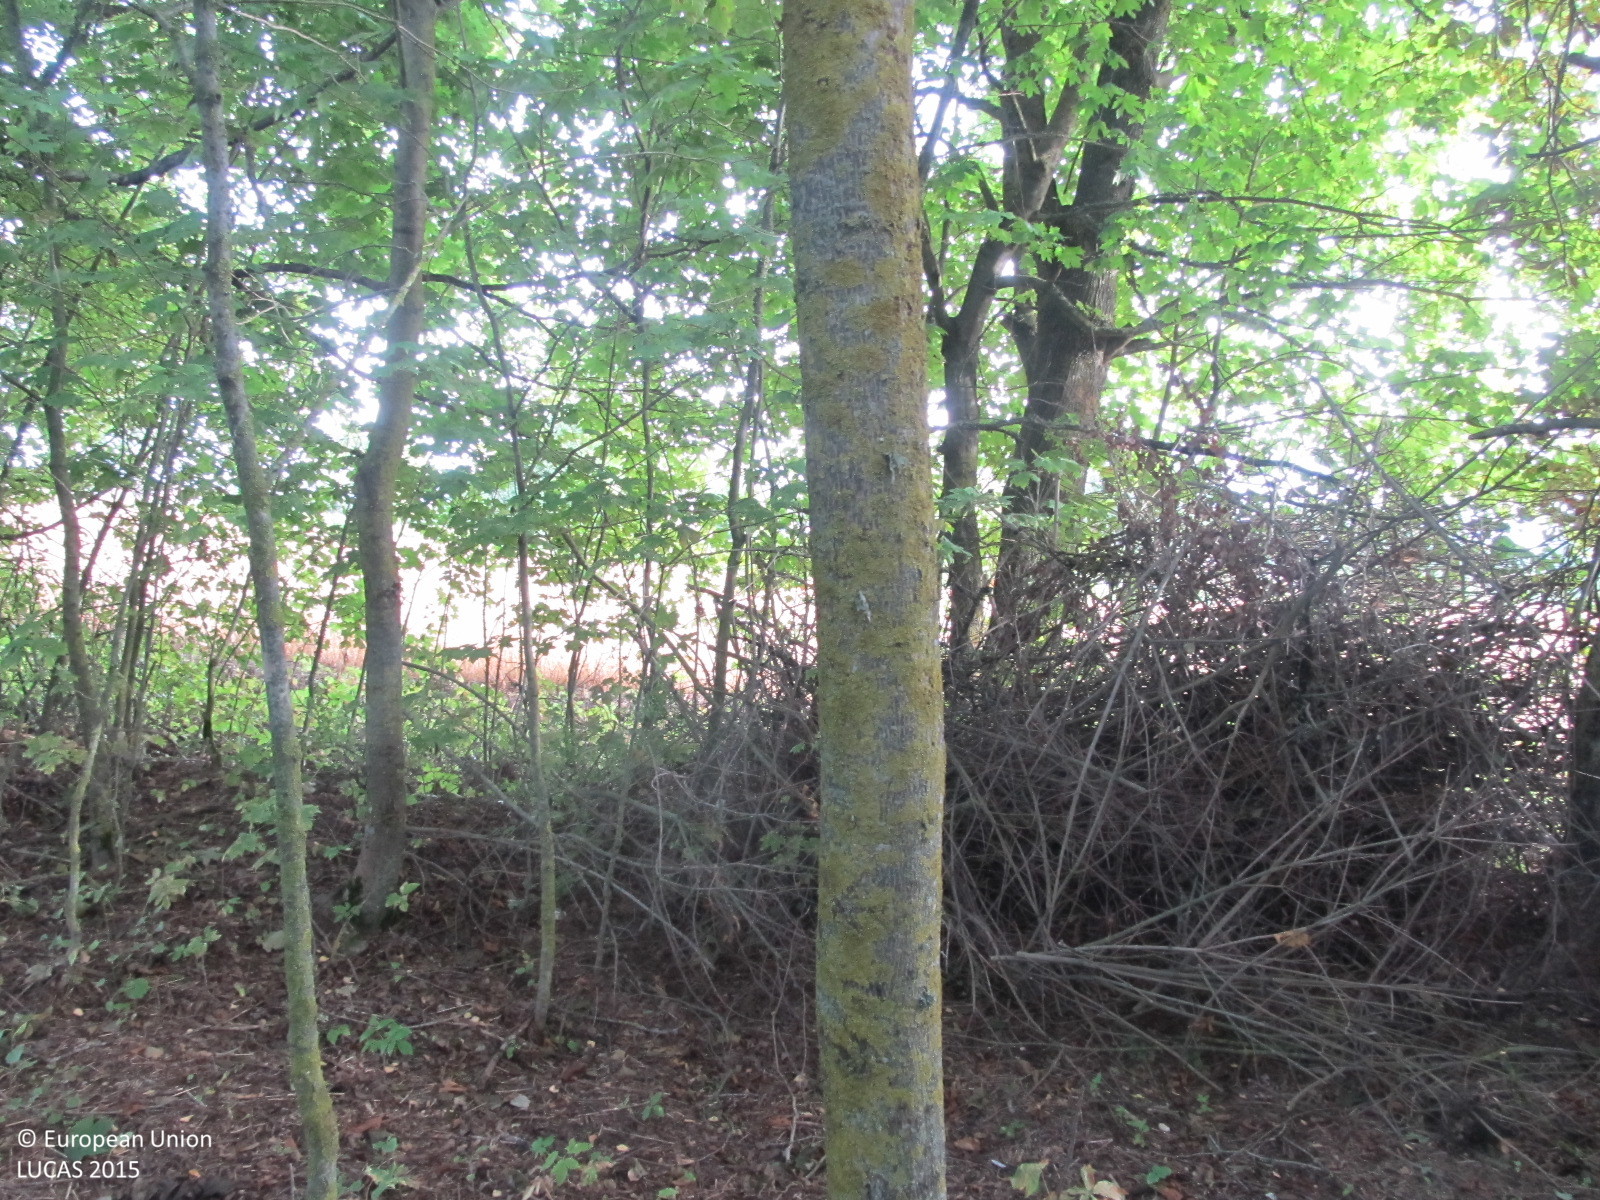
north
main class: Woodland
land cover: Broadleaved woodland
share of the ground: > 75 %
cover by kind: broadleaved forest trees 90 %, herbaceous plants 5 %, unconsolidated bare surface 5 %
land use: Forestry
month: September
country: LT
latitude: 56.3324
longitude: 23.2859
